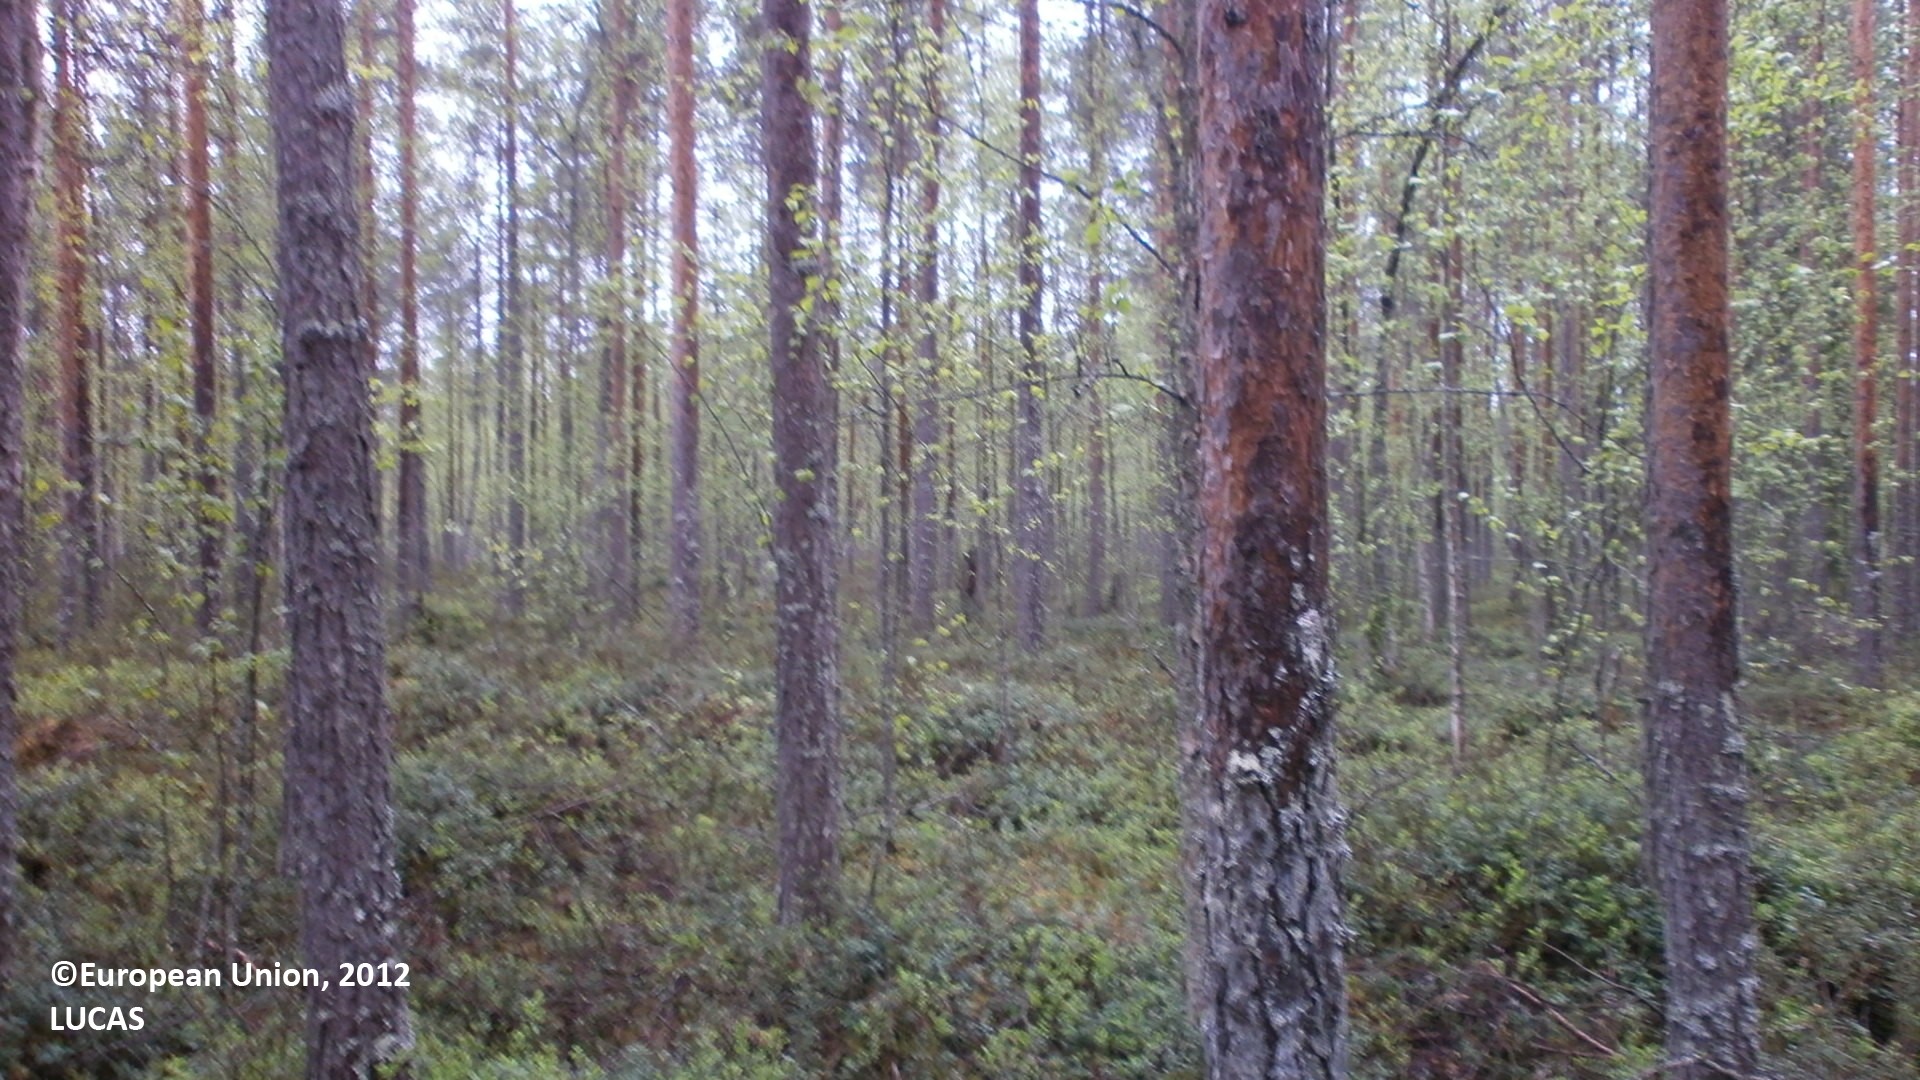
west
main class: Woodland
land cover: Pine dominated coniferous woodland
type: mire and swamp forests
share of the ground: 50 - 75 %
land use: Forestry
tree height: > 5 m
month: June
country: FI
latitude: 64.1227
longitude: 26.1065
